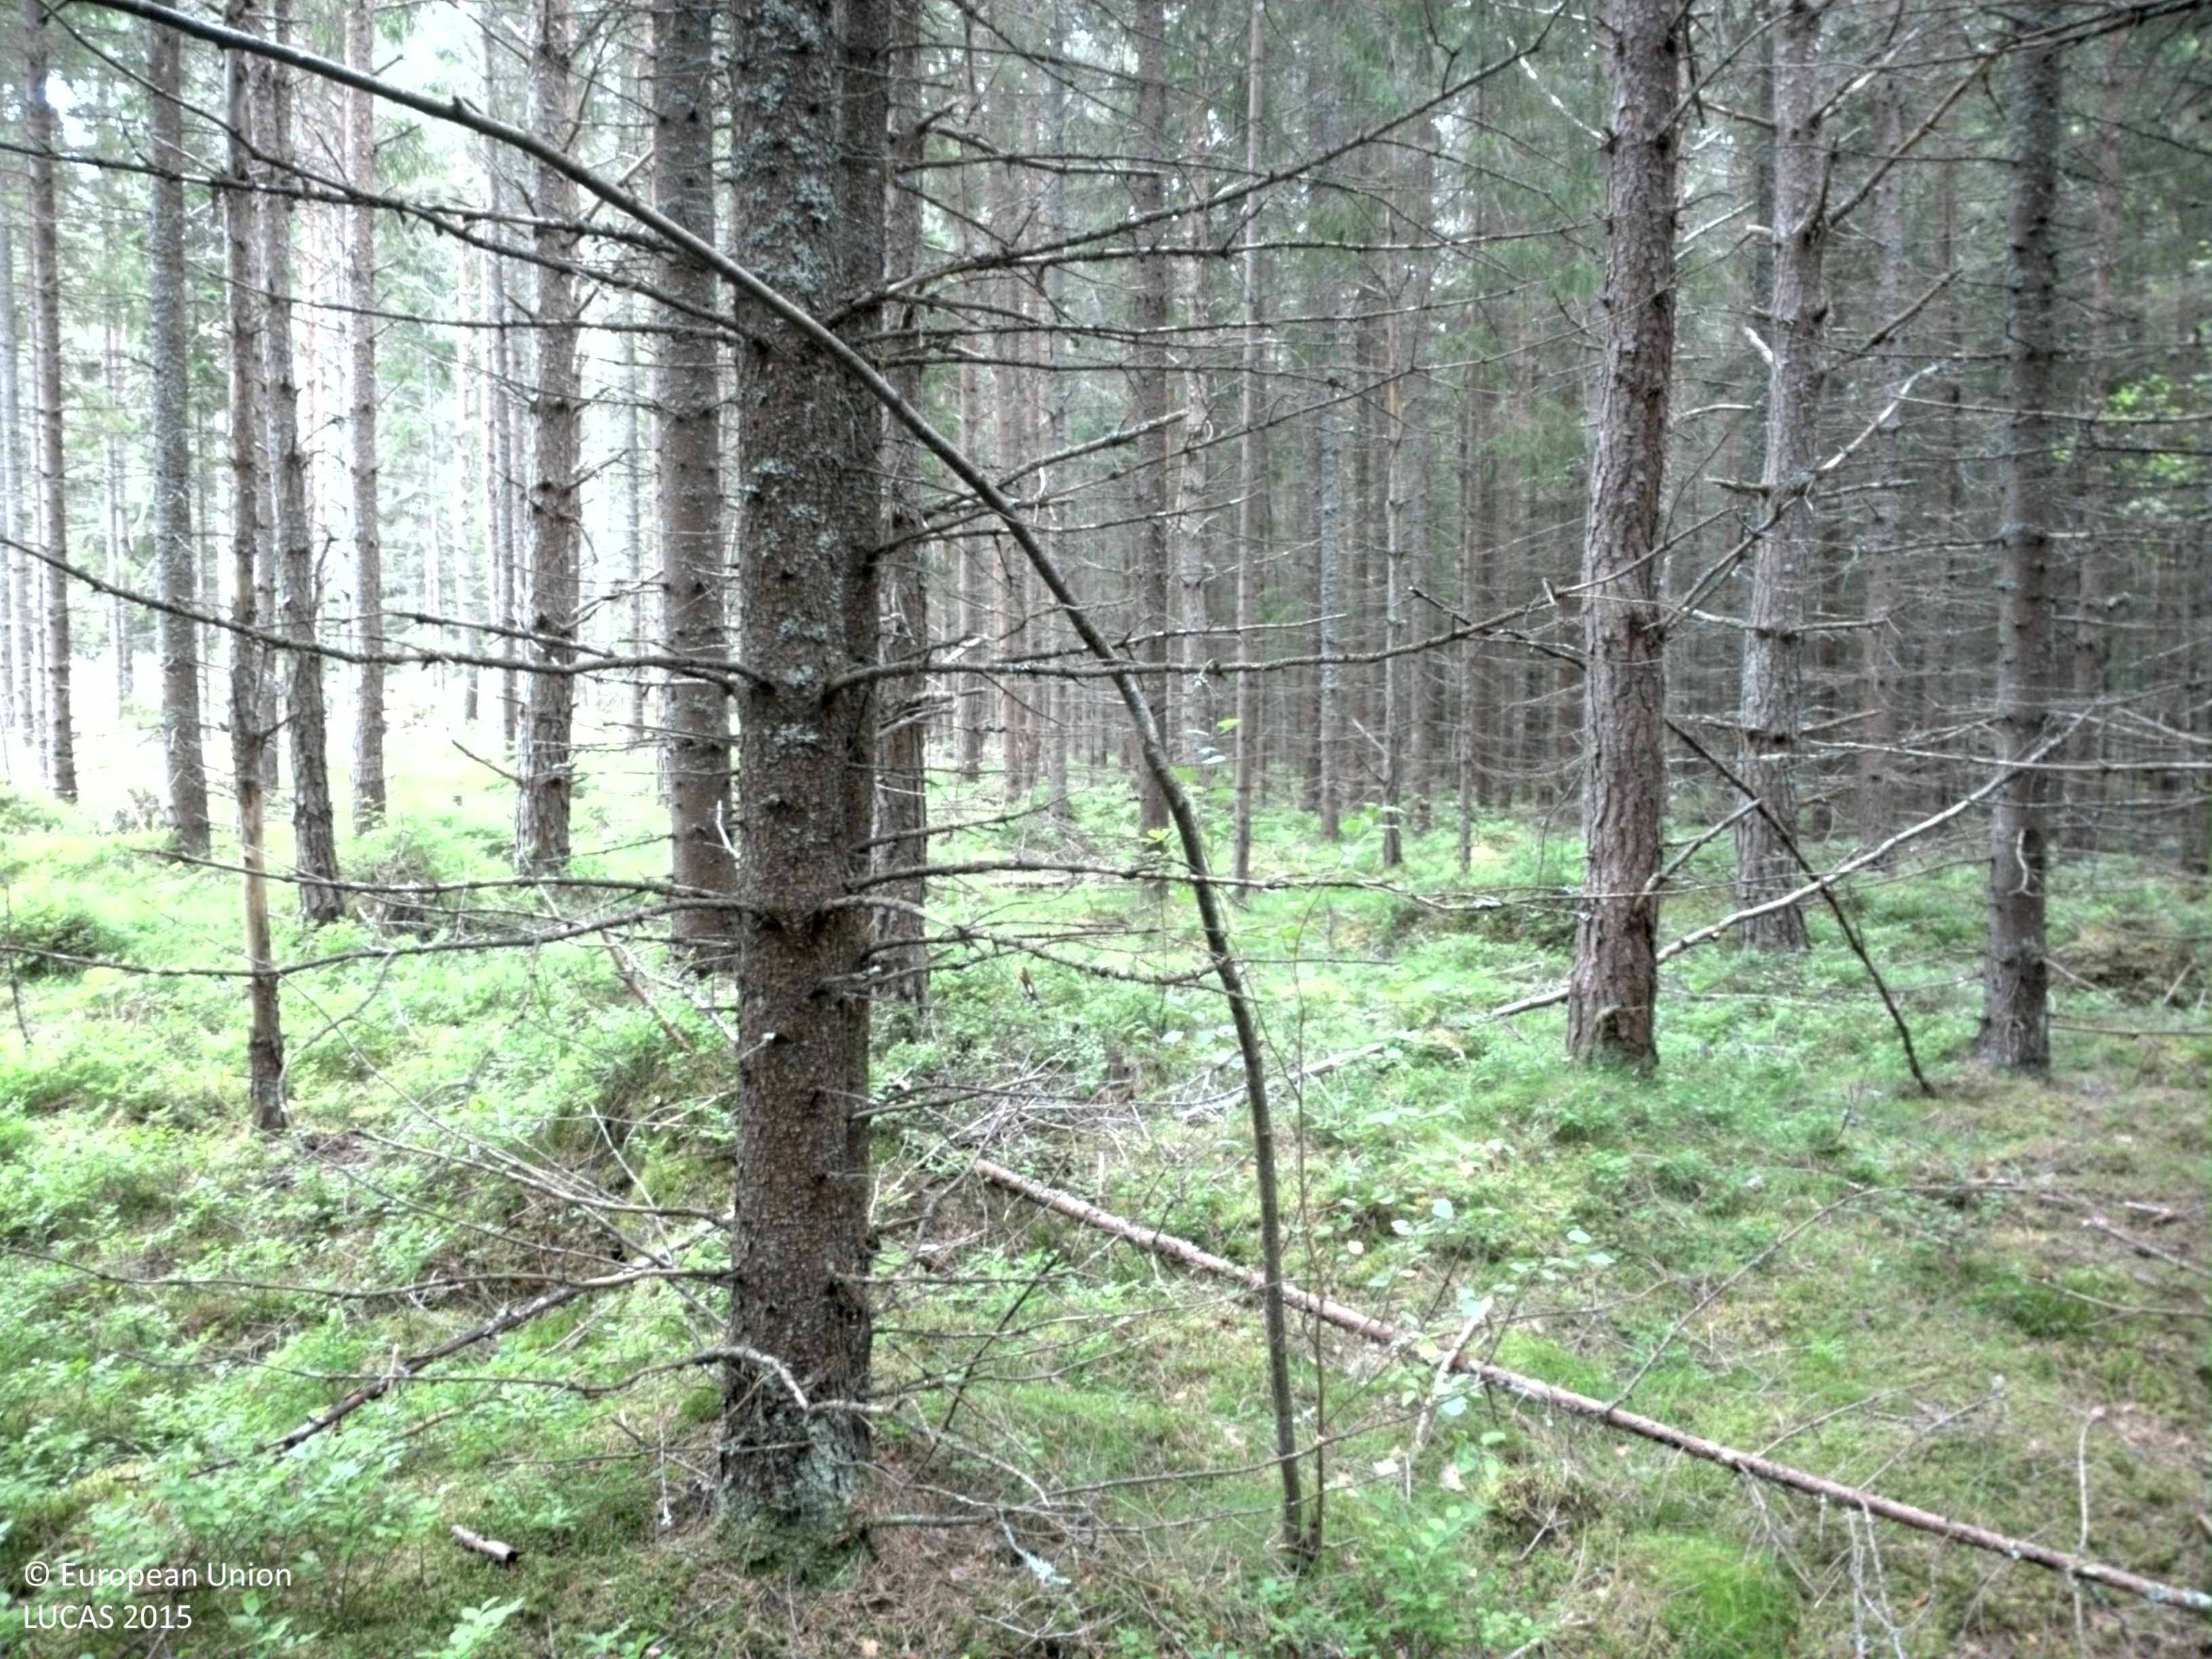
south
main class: Woodland
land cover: Other coniferous woodland
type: boreal forest
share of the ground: 25 - 50 %
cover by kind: coniferous forest trees 45 %, herbaceous plants 35 %, lichens and mosses 20 %
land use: Forestry
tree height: > 5 m
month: July
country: SE
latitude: 58.9385
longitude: 14.4582
